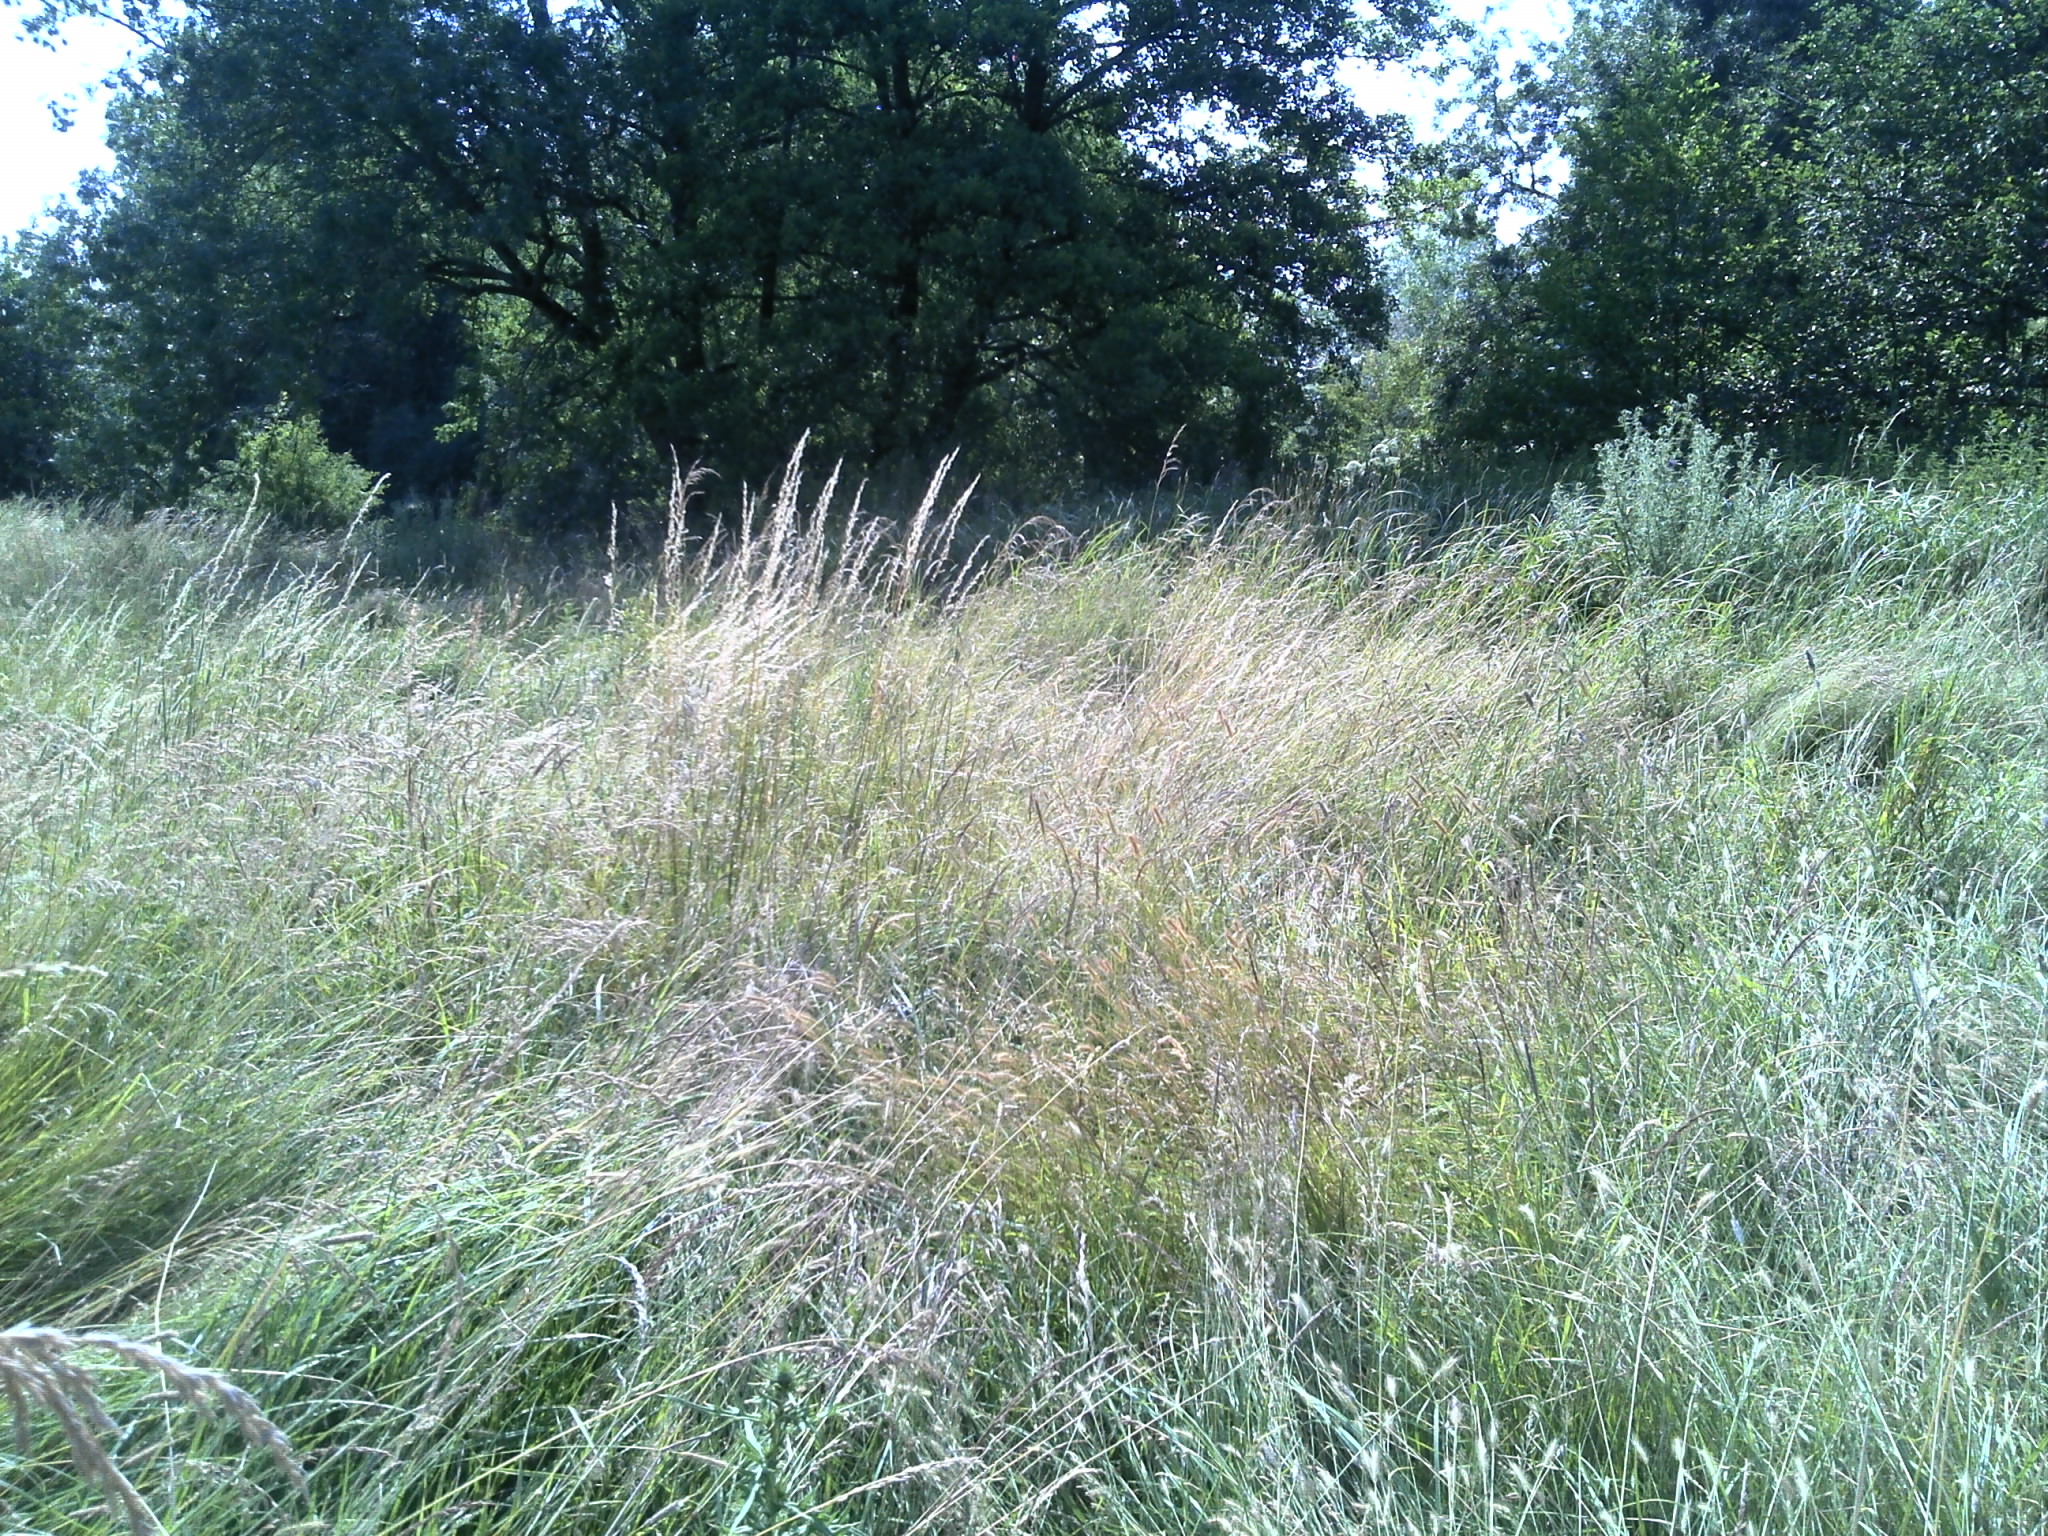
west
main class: Grassland
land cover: Grassland without tree/shrub cover
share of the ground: > 75 %
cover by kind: herbaceous plants 100 %
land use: Agriculture (excluding fallow land and kitchen gardens)
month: July
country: FR
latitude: 46.8021
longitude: 1.6429
